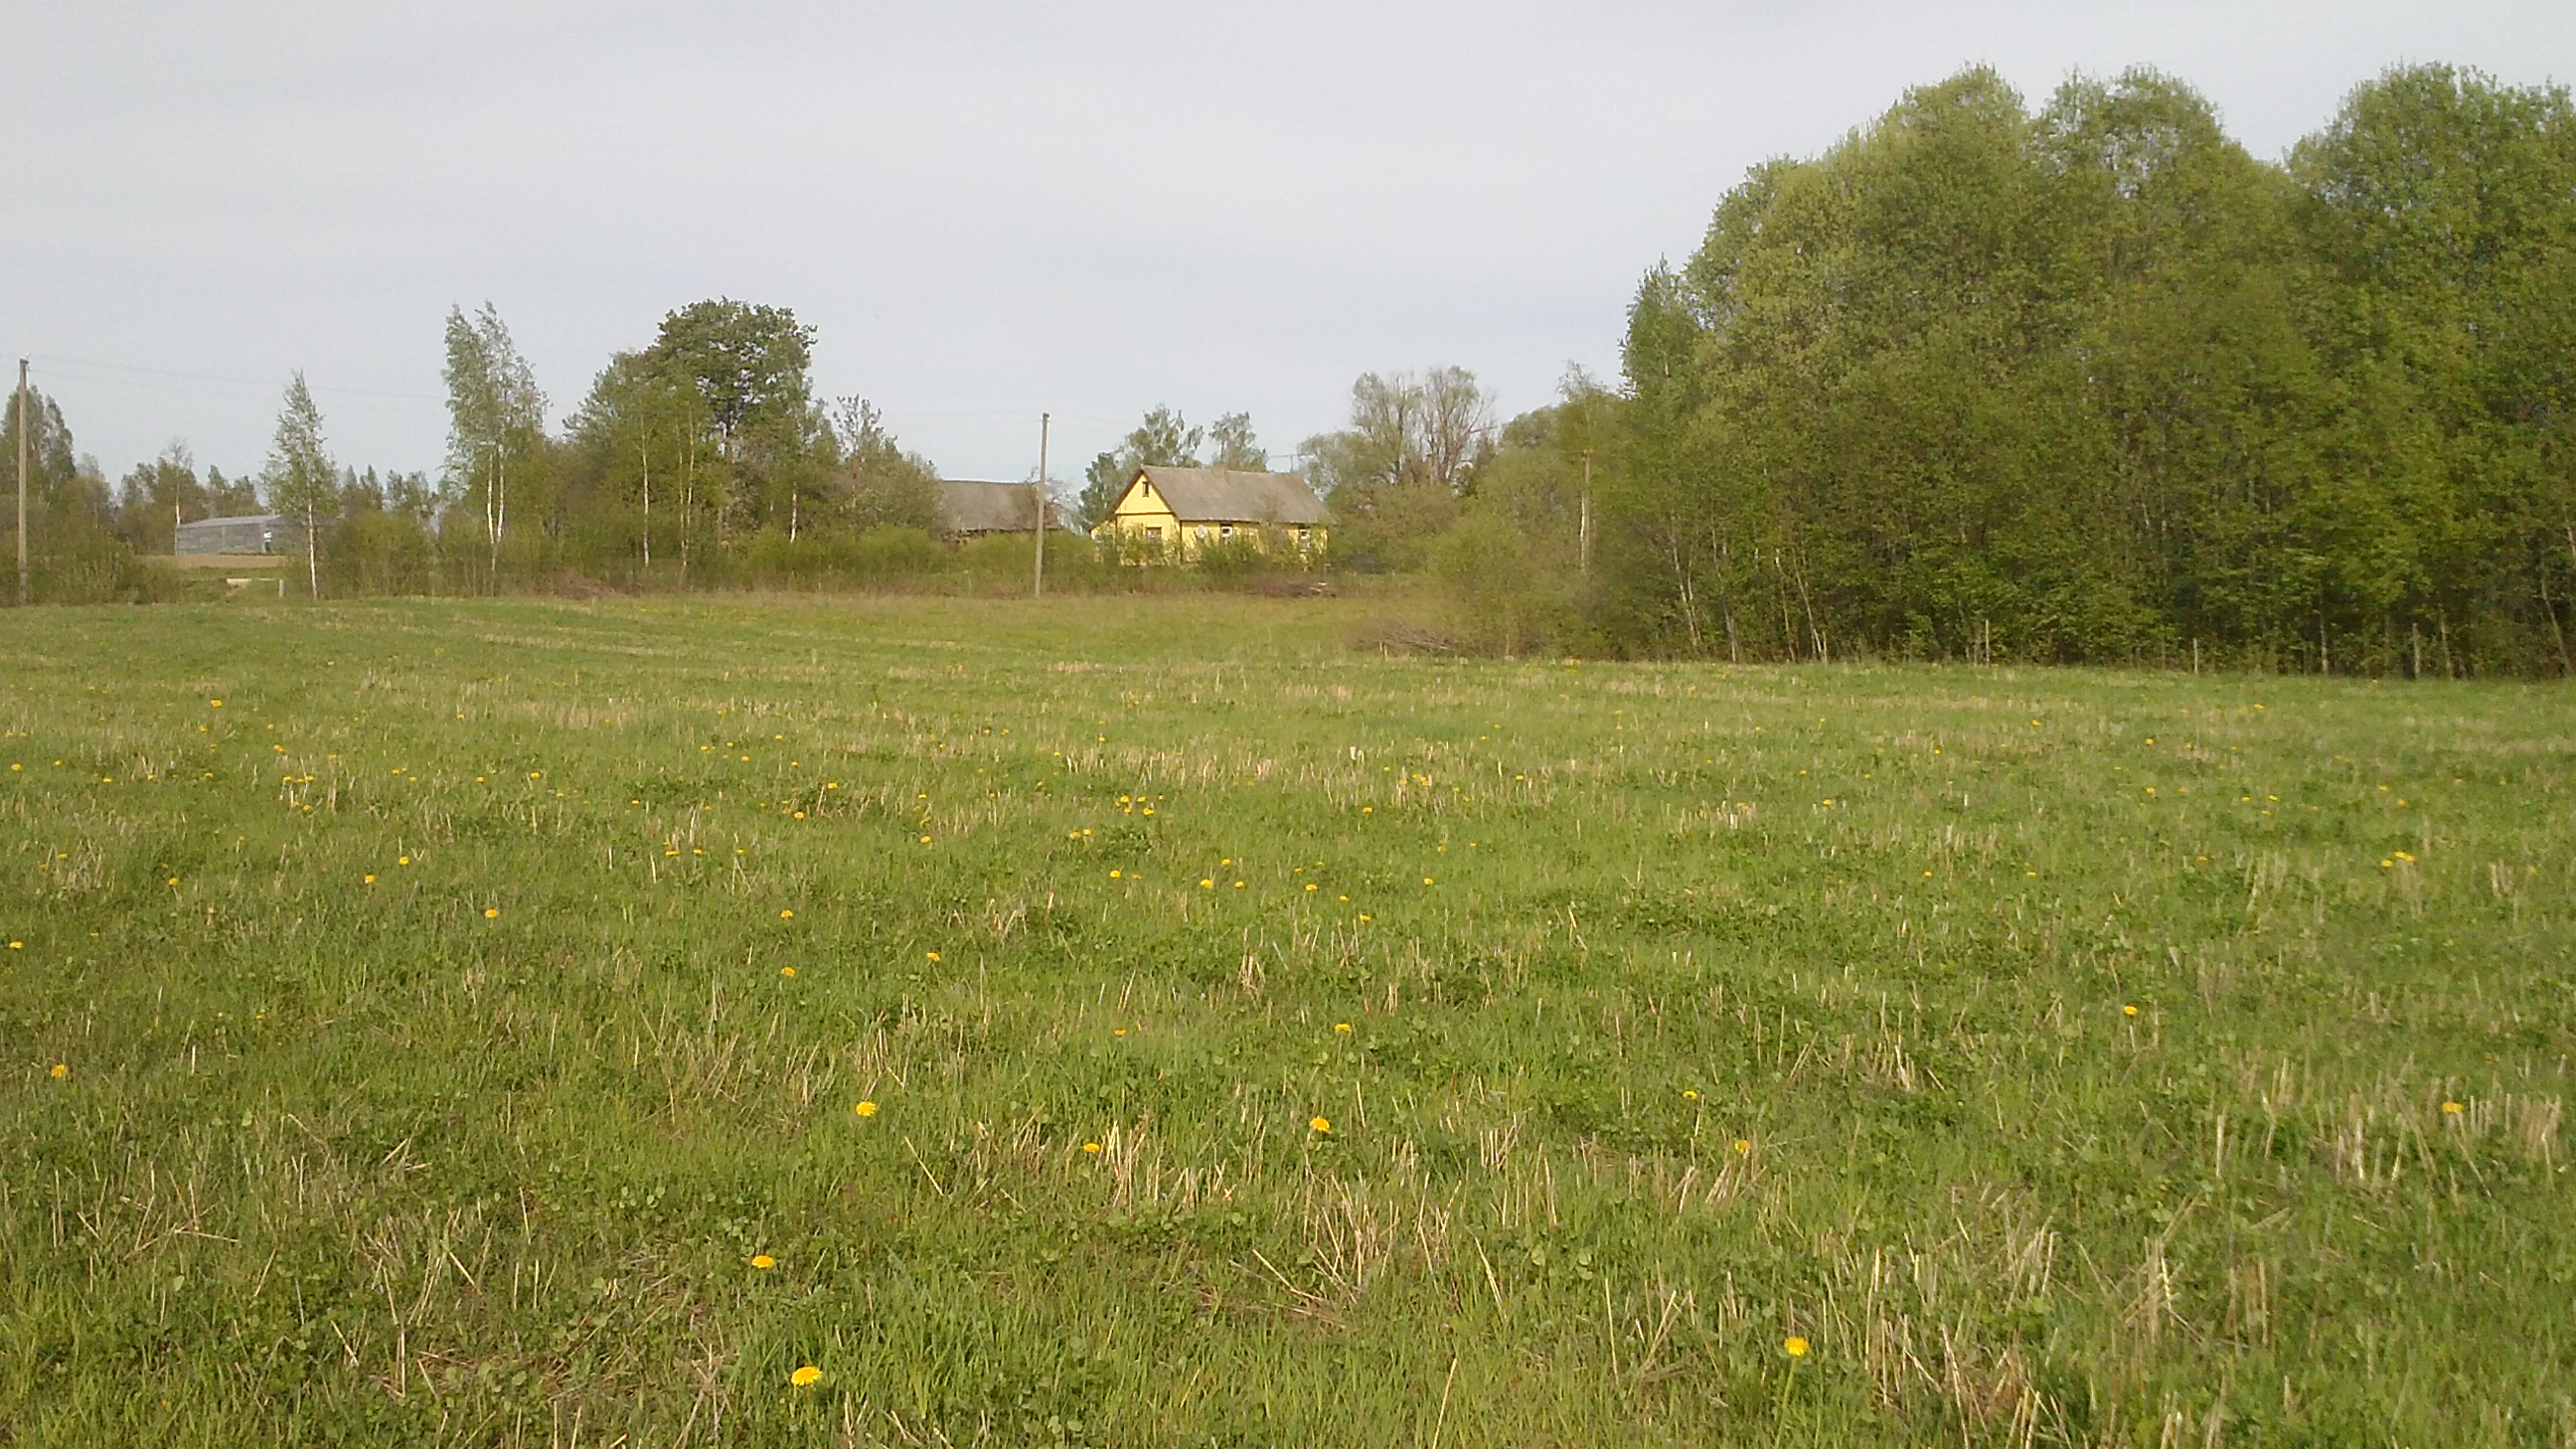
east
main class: Grassland
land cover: Grassland without tree/shrub cover
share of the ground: > 75 %
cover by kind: herbaceous plants 100 %
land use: Agriculture (excluding fallow land and kitchen gardens)
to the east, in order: Grassland without tree/shrub cover; Broadleaved woodland; Grassland without tree/shrub cover; Broadleaved woodland; Electric lines; Paved roads, cycling and walking lanes; Grass margins; Electric lines; Broadleaved woodland
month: May
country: LV
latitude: 56.0103
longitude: 27.5868
